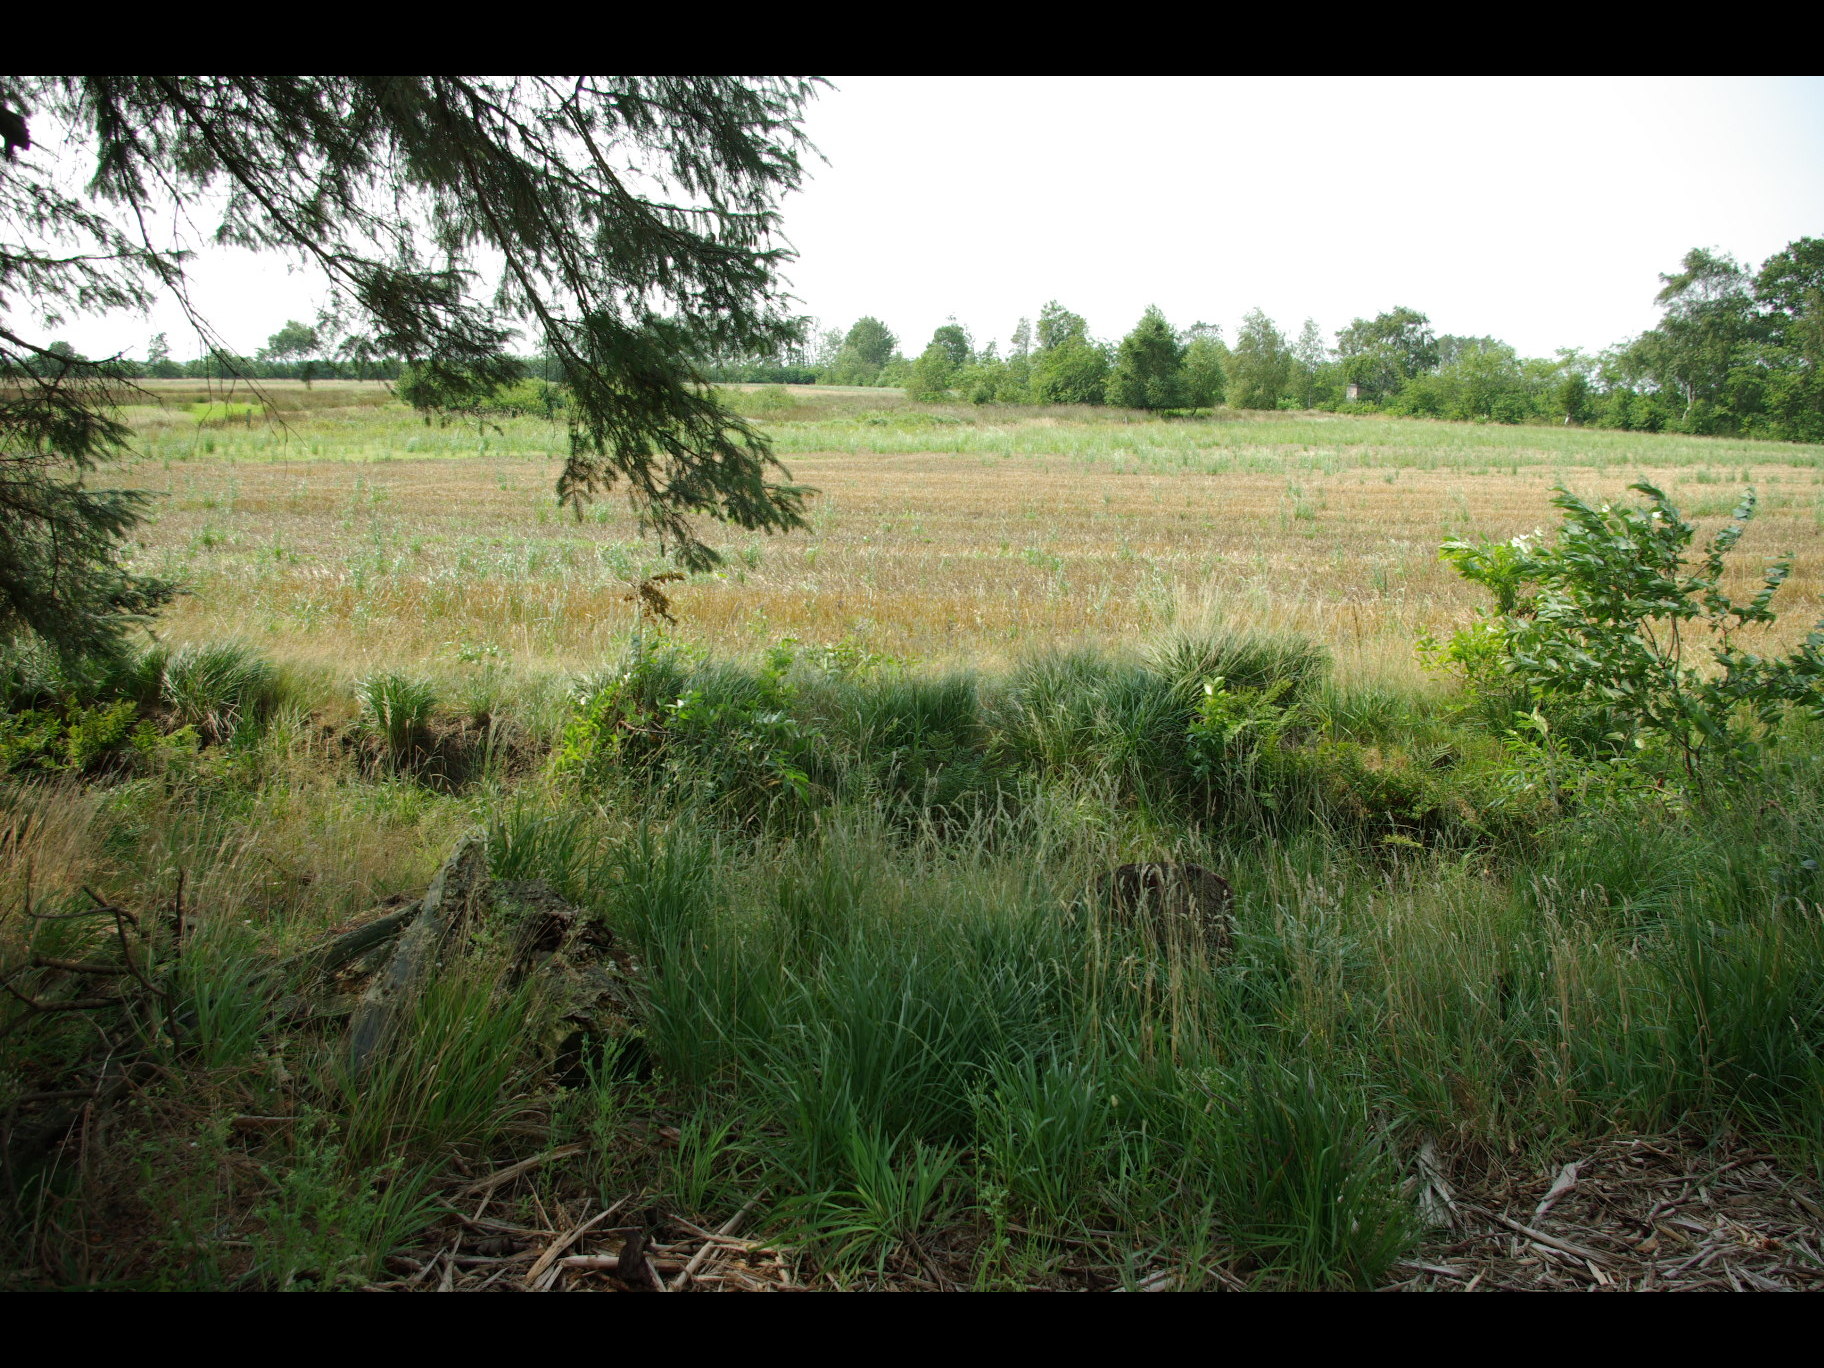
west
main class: Woodland
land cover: Spruce dominated coniferous woodland
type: hemiboreal forest and nemoral coniferous forest and mixed broadleaved-coniferous forest
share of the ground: 50 - 75 %
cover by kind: coniferous forest trees 60 %, herbaceous plants 30 %, unconsolidated bare surface 10 %
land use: Forestry
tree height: > 5 m
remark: Clear cut
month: August
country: DE
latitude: 54.5502
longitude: 9.3048
